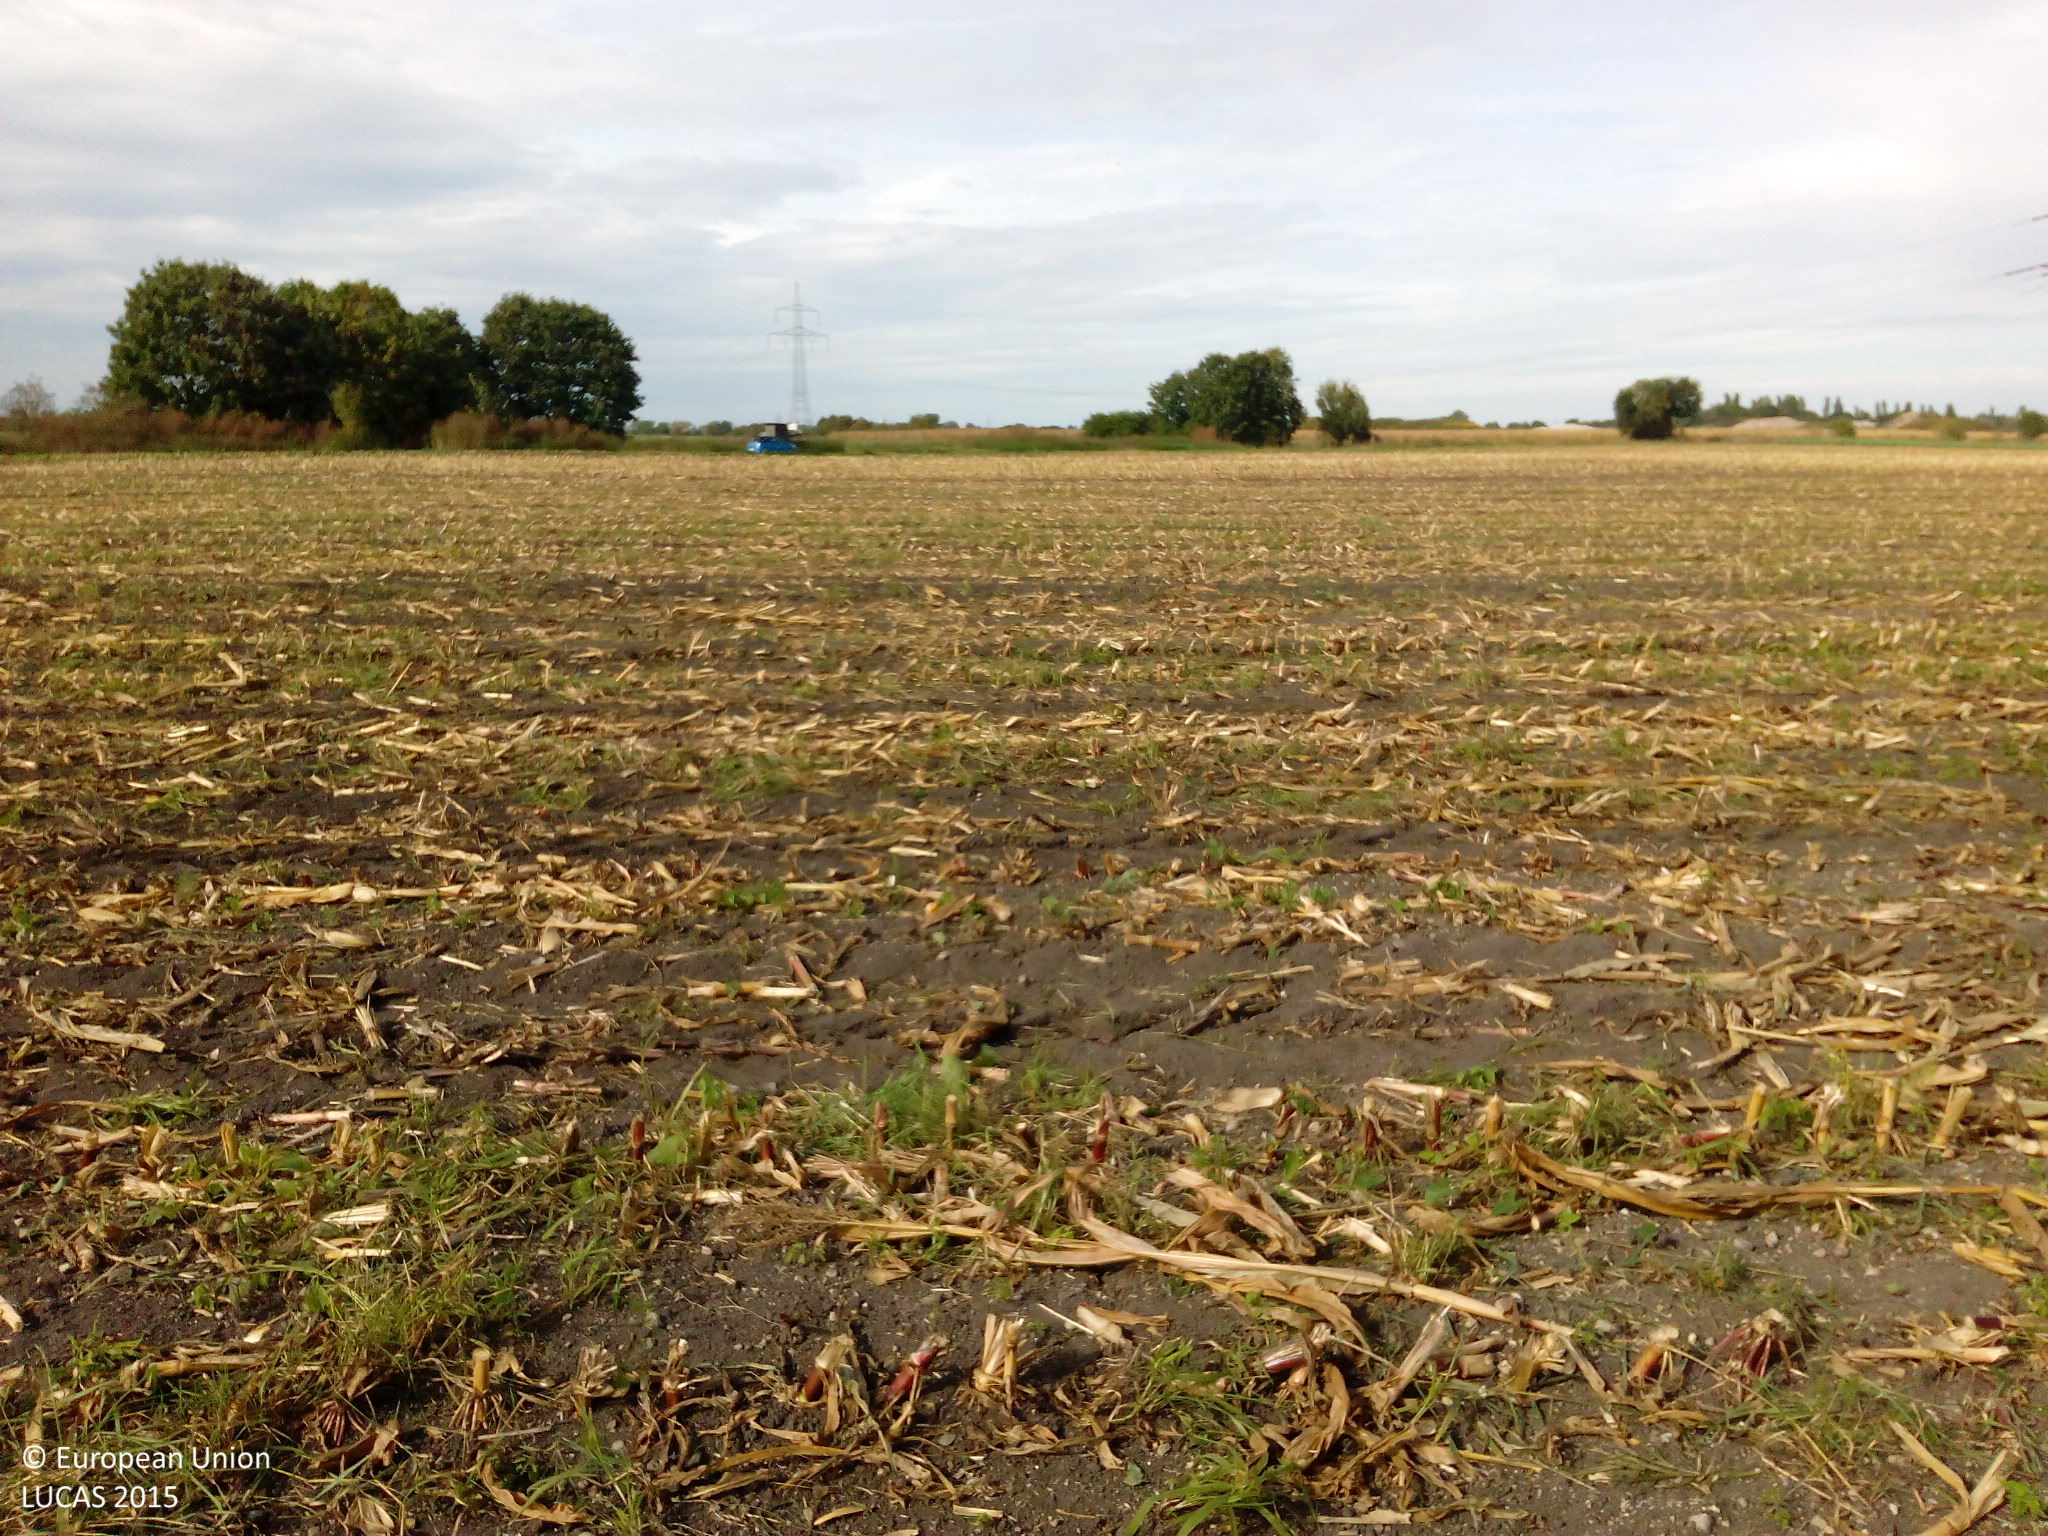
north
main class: Cropland
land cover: Maize
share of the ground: < 10 %
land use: Agriculture (excluding fallow land and kitchen gardens)
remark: Harvested field
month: September
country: DE
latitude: 48.3691
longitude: 11.9025
